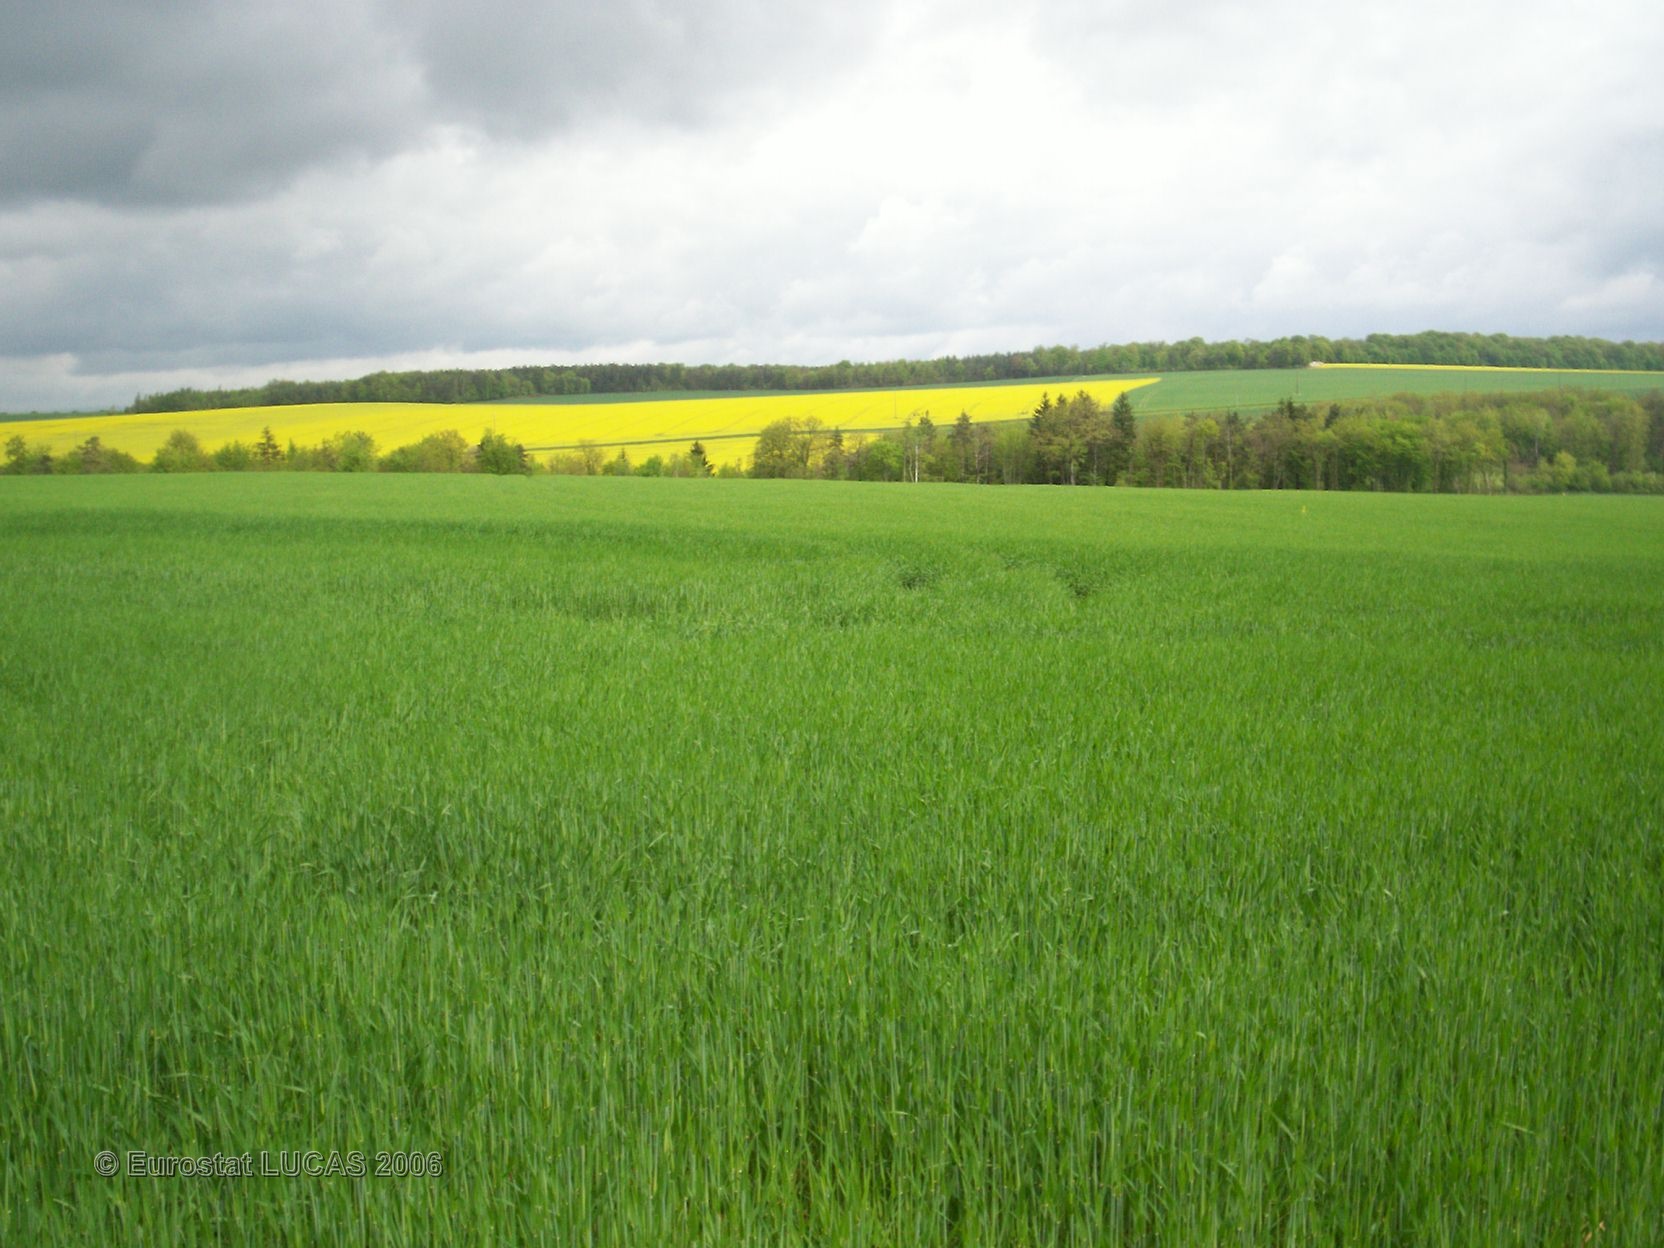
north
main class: Grassland
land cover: Grassland without tree/shrub cover
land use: Agriculture (excluding fallow land and kitchen gardens)
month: May
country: FR
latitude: 47.7663
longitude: 4.5950
